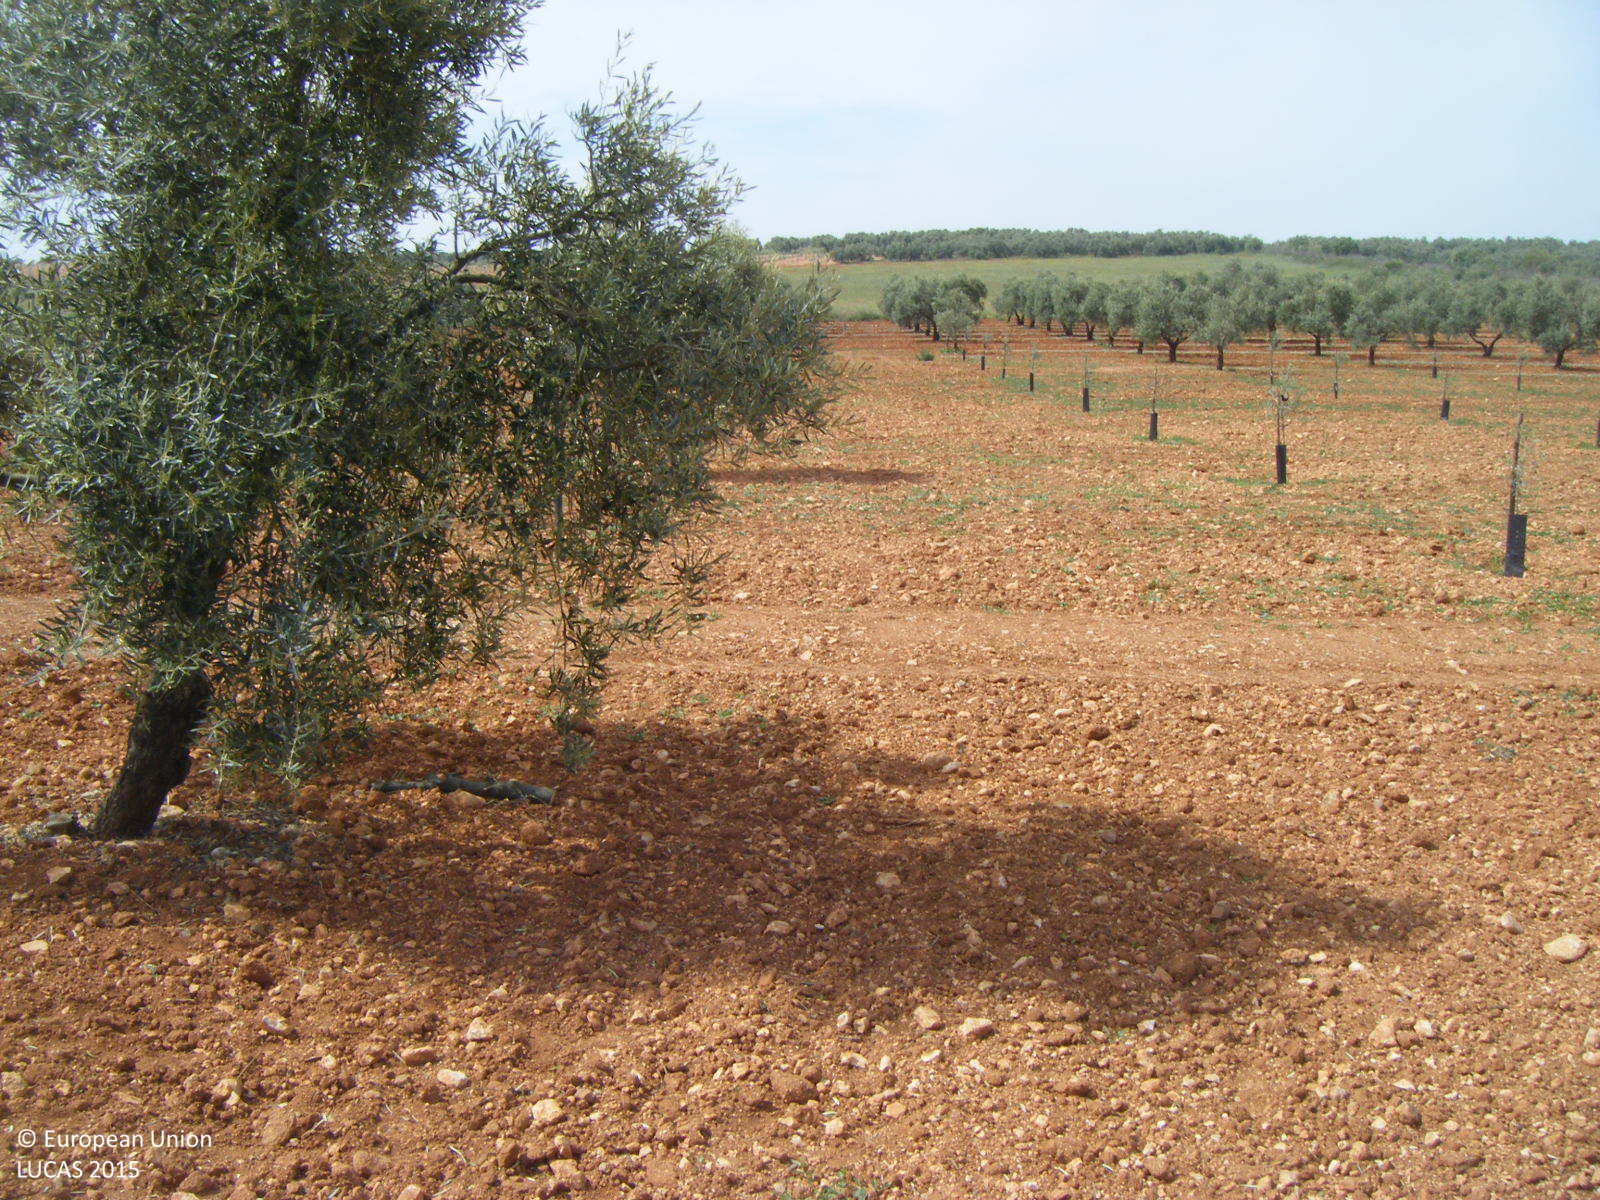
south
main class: Cropland
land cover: Olive groves
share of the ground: 10 - 25 %
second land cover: Other bare soil
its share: > 75 %
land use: Agriculture (excluding fallow land and kitchen gardens)
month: April
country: ES
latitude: 37.1052
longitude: -4.7527
